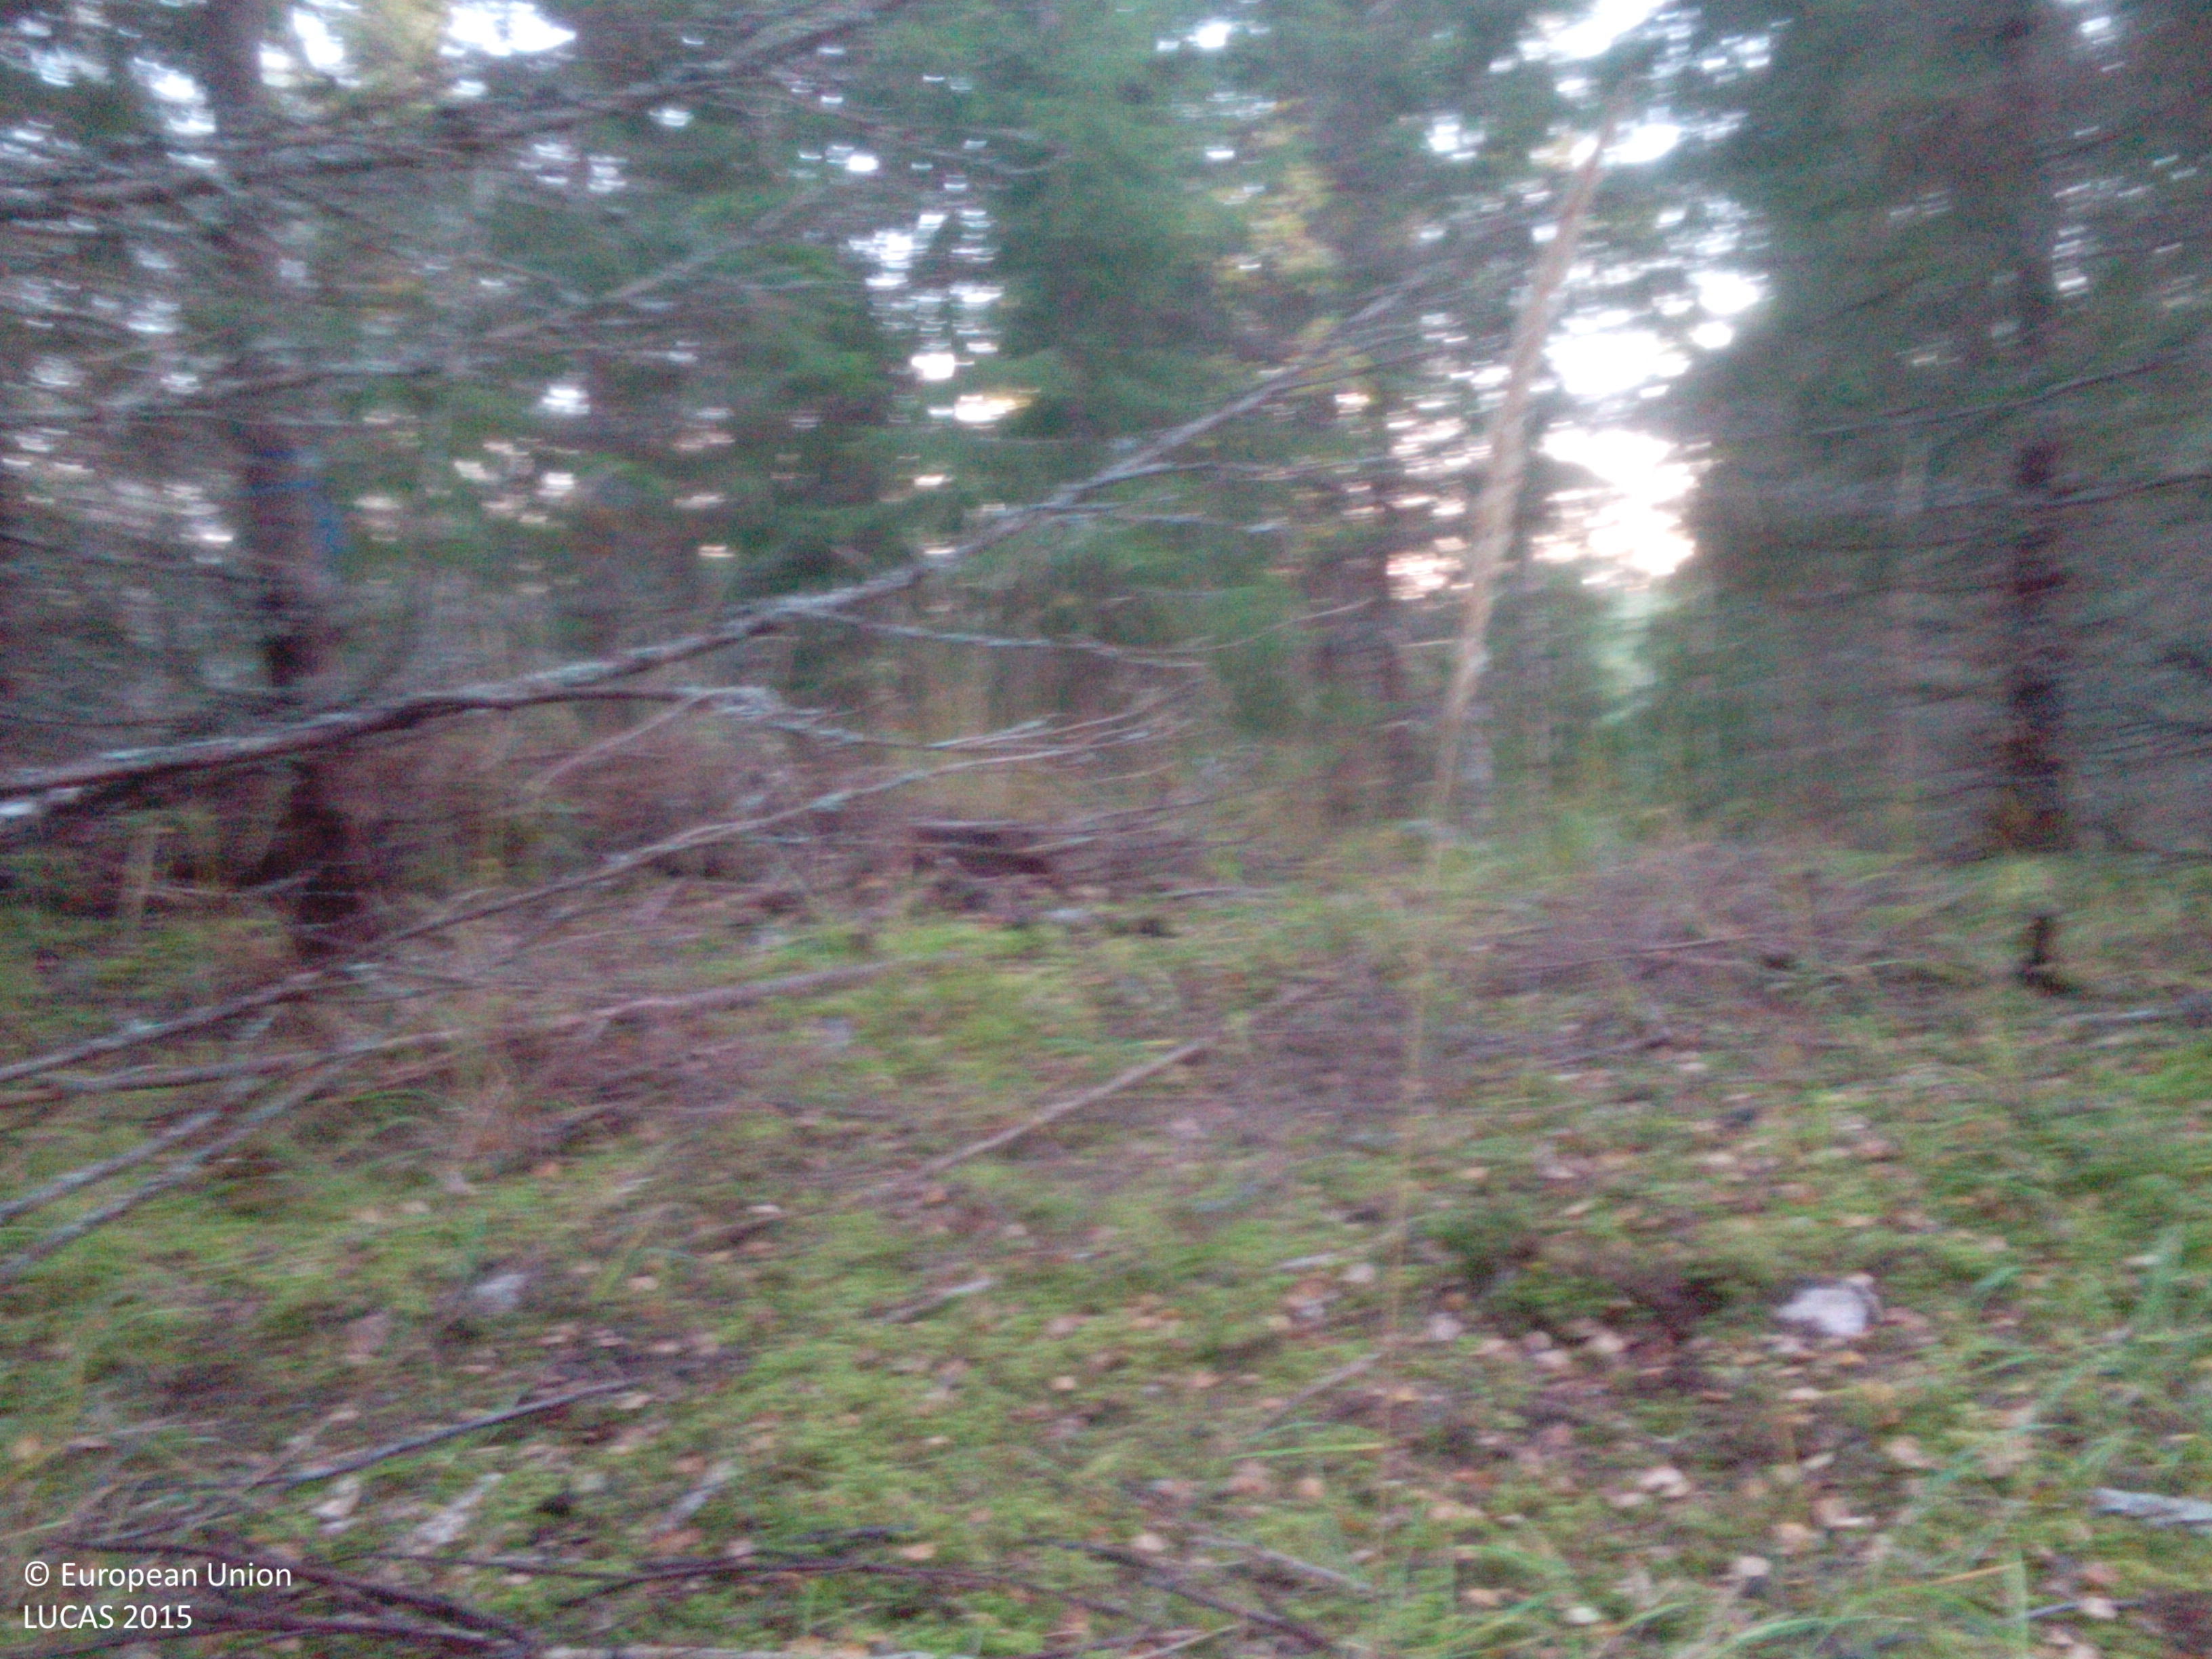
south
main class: Woodland
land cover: Spruce dominated mixed woodland
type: boreal forest
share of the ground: 50 - 75 %
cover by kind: coniferous forest trees 50 %, broadleaved forest trees 25 %, lichens and mosses 20 %, herbaceous plants 5 %
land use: Forestry
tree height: > 5 m
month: October
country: SE
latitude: 58.9008
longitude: 16.3298
